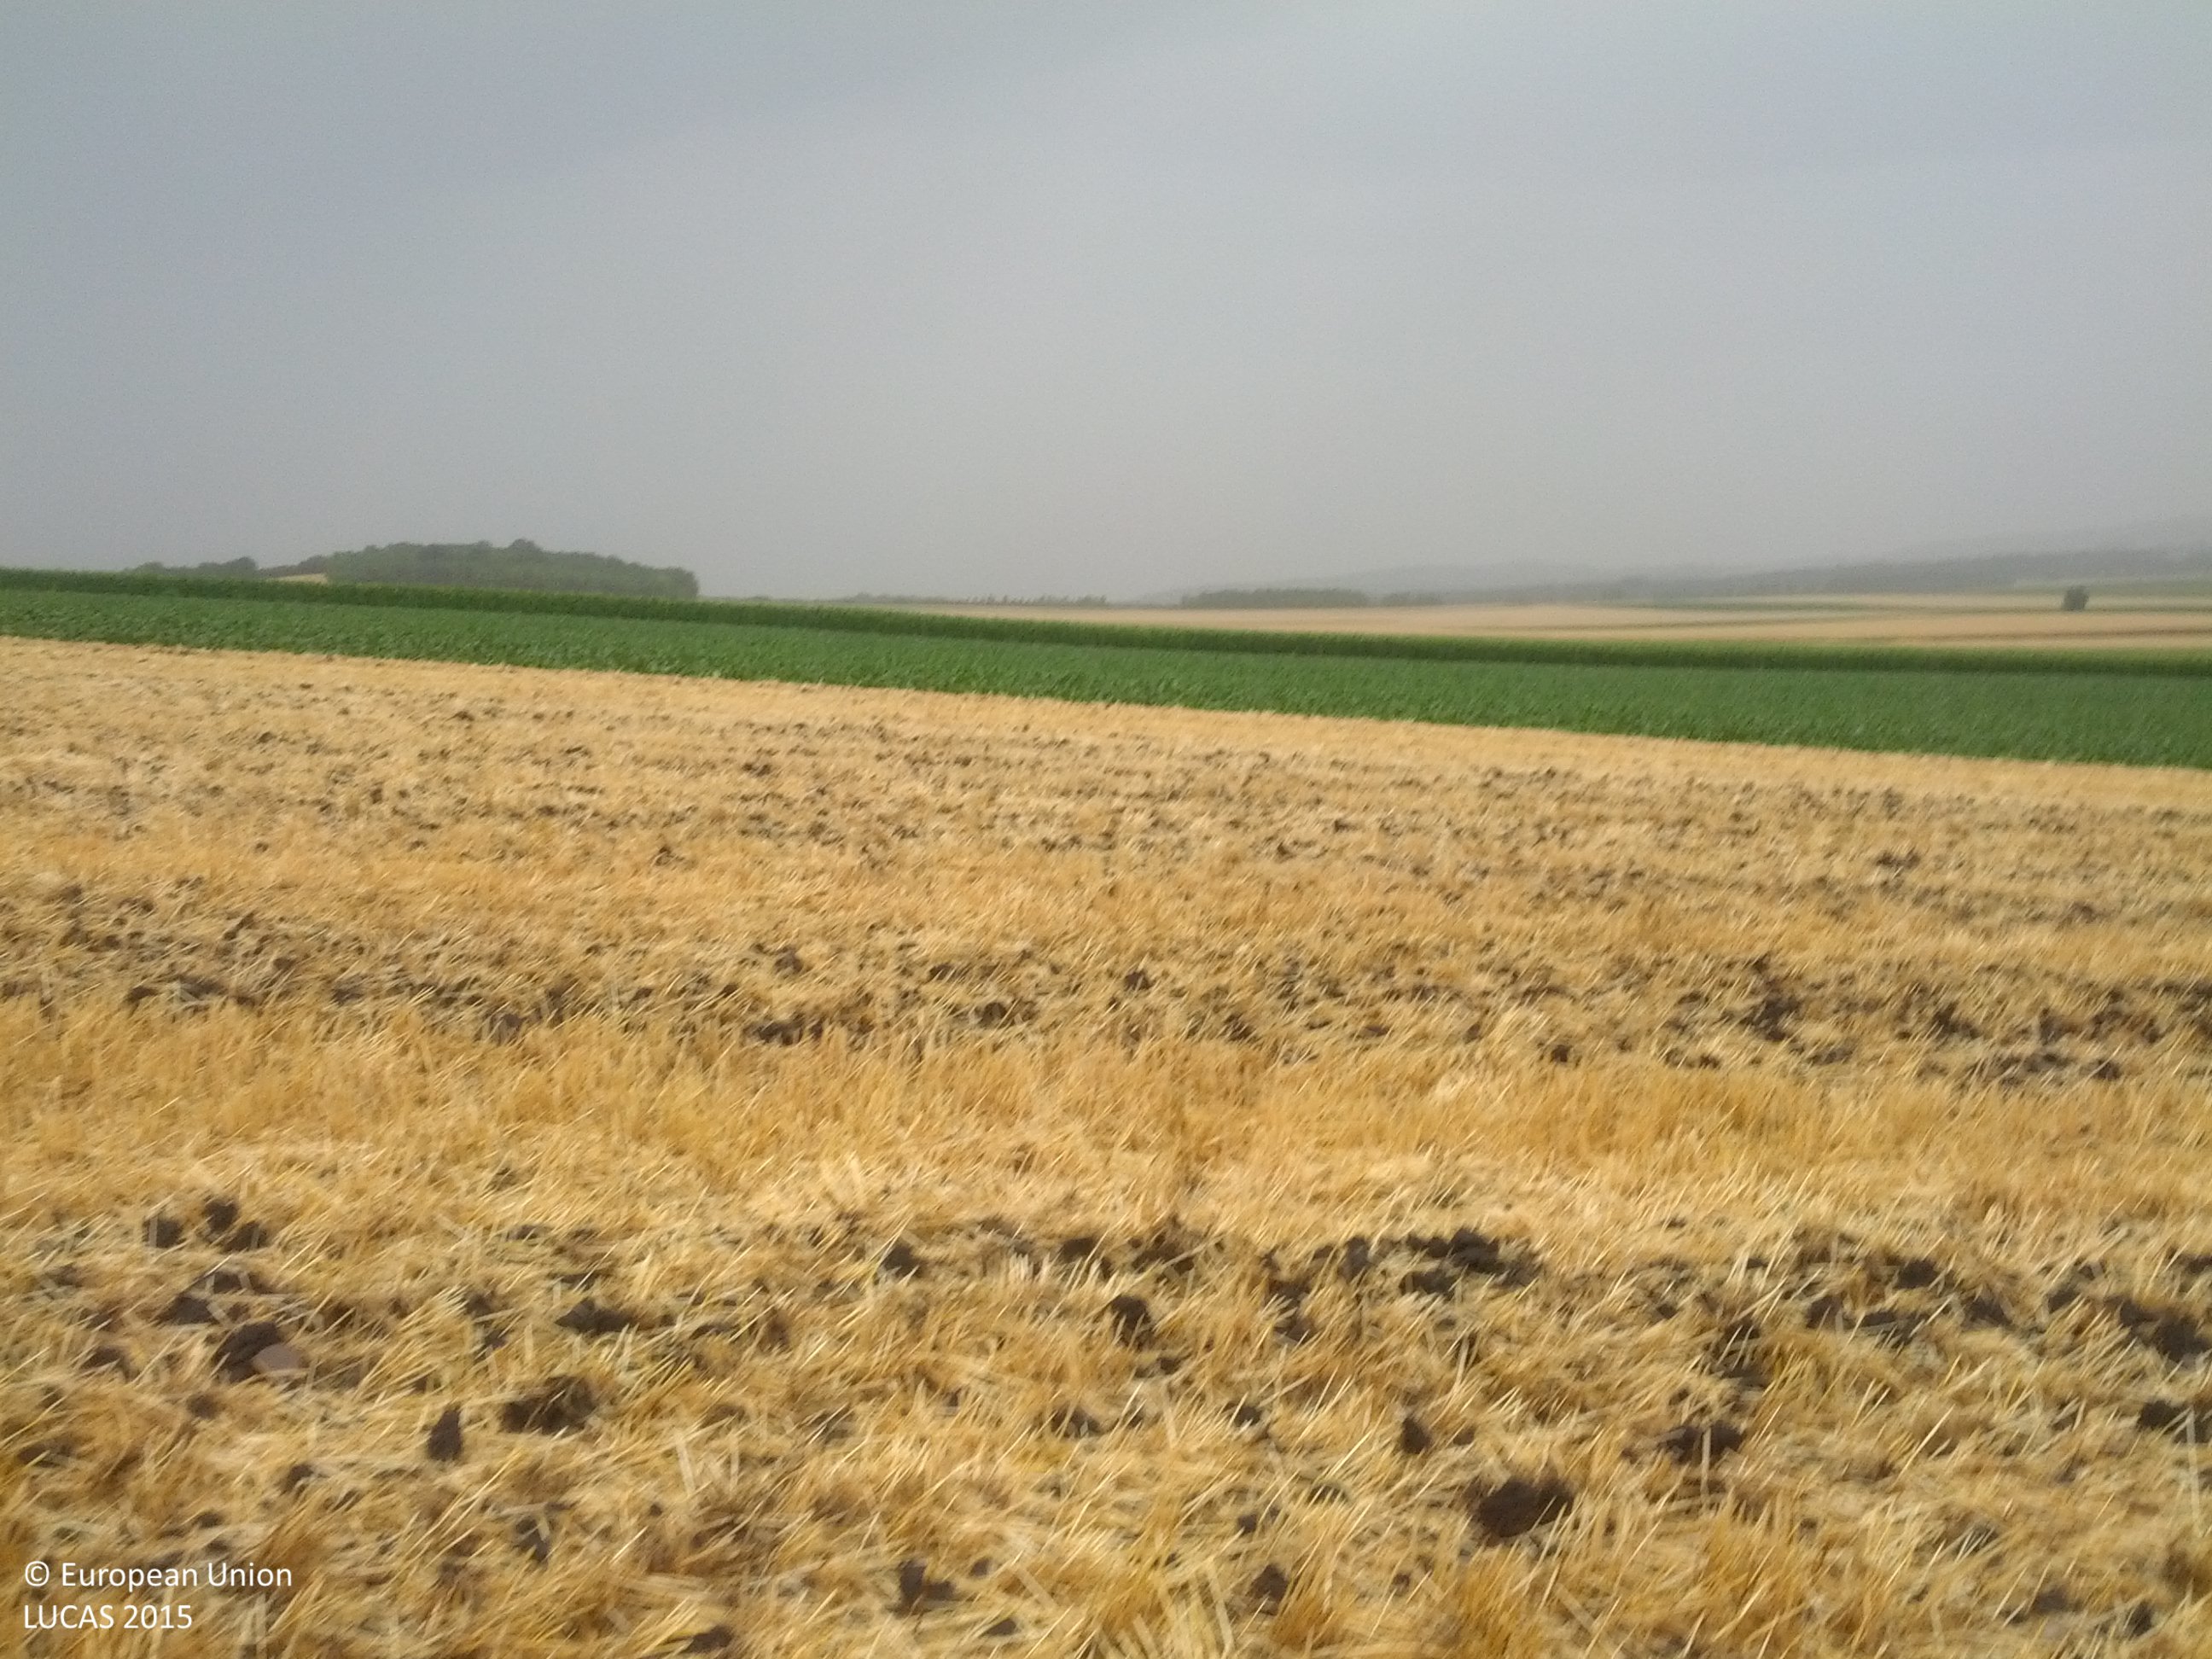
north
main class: Cropland
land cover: Barley
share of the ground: < 10 %
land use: Agriculture (excluding fallow land and kitchen gardens)
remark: Harvested field
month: July
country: AT
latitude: 48.7882
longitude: 16.5263
